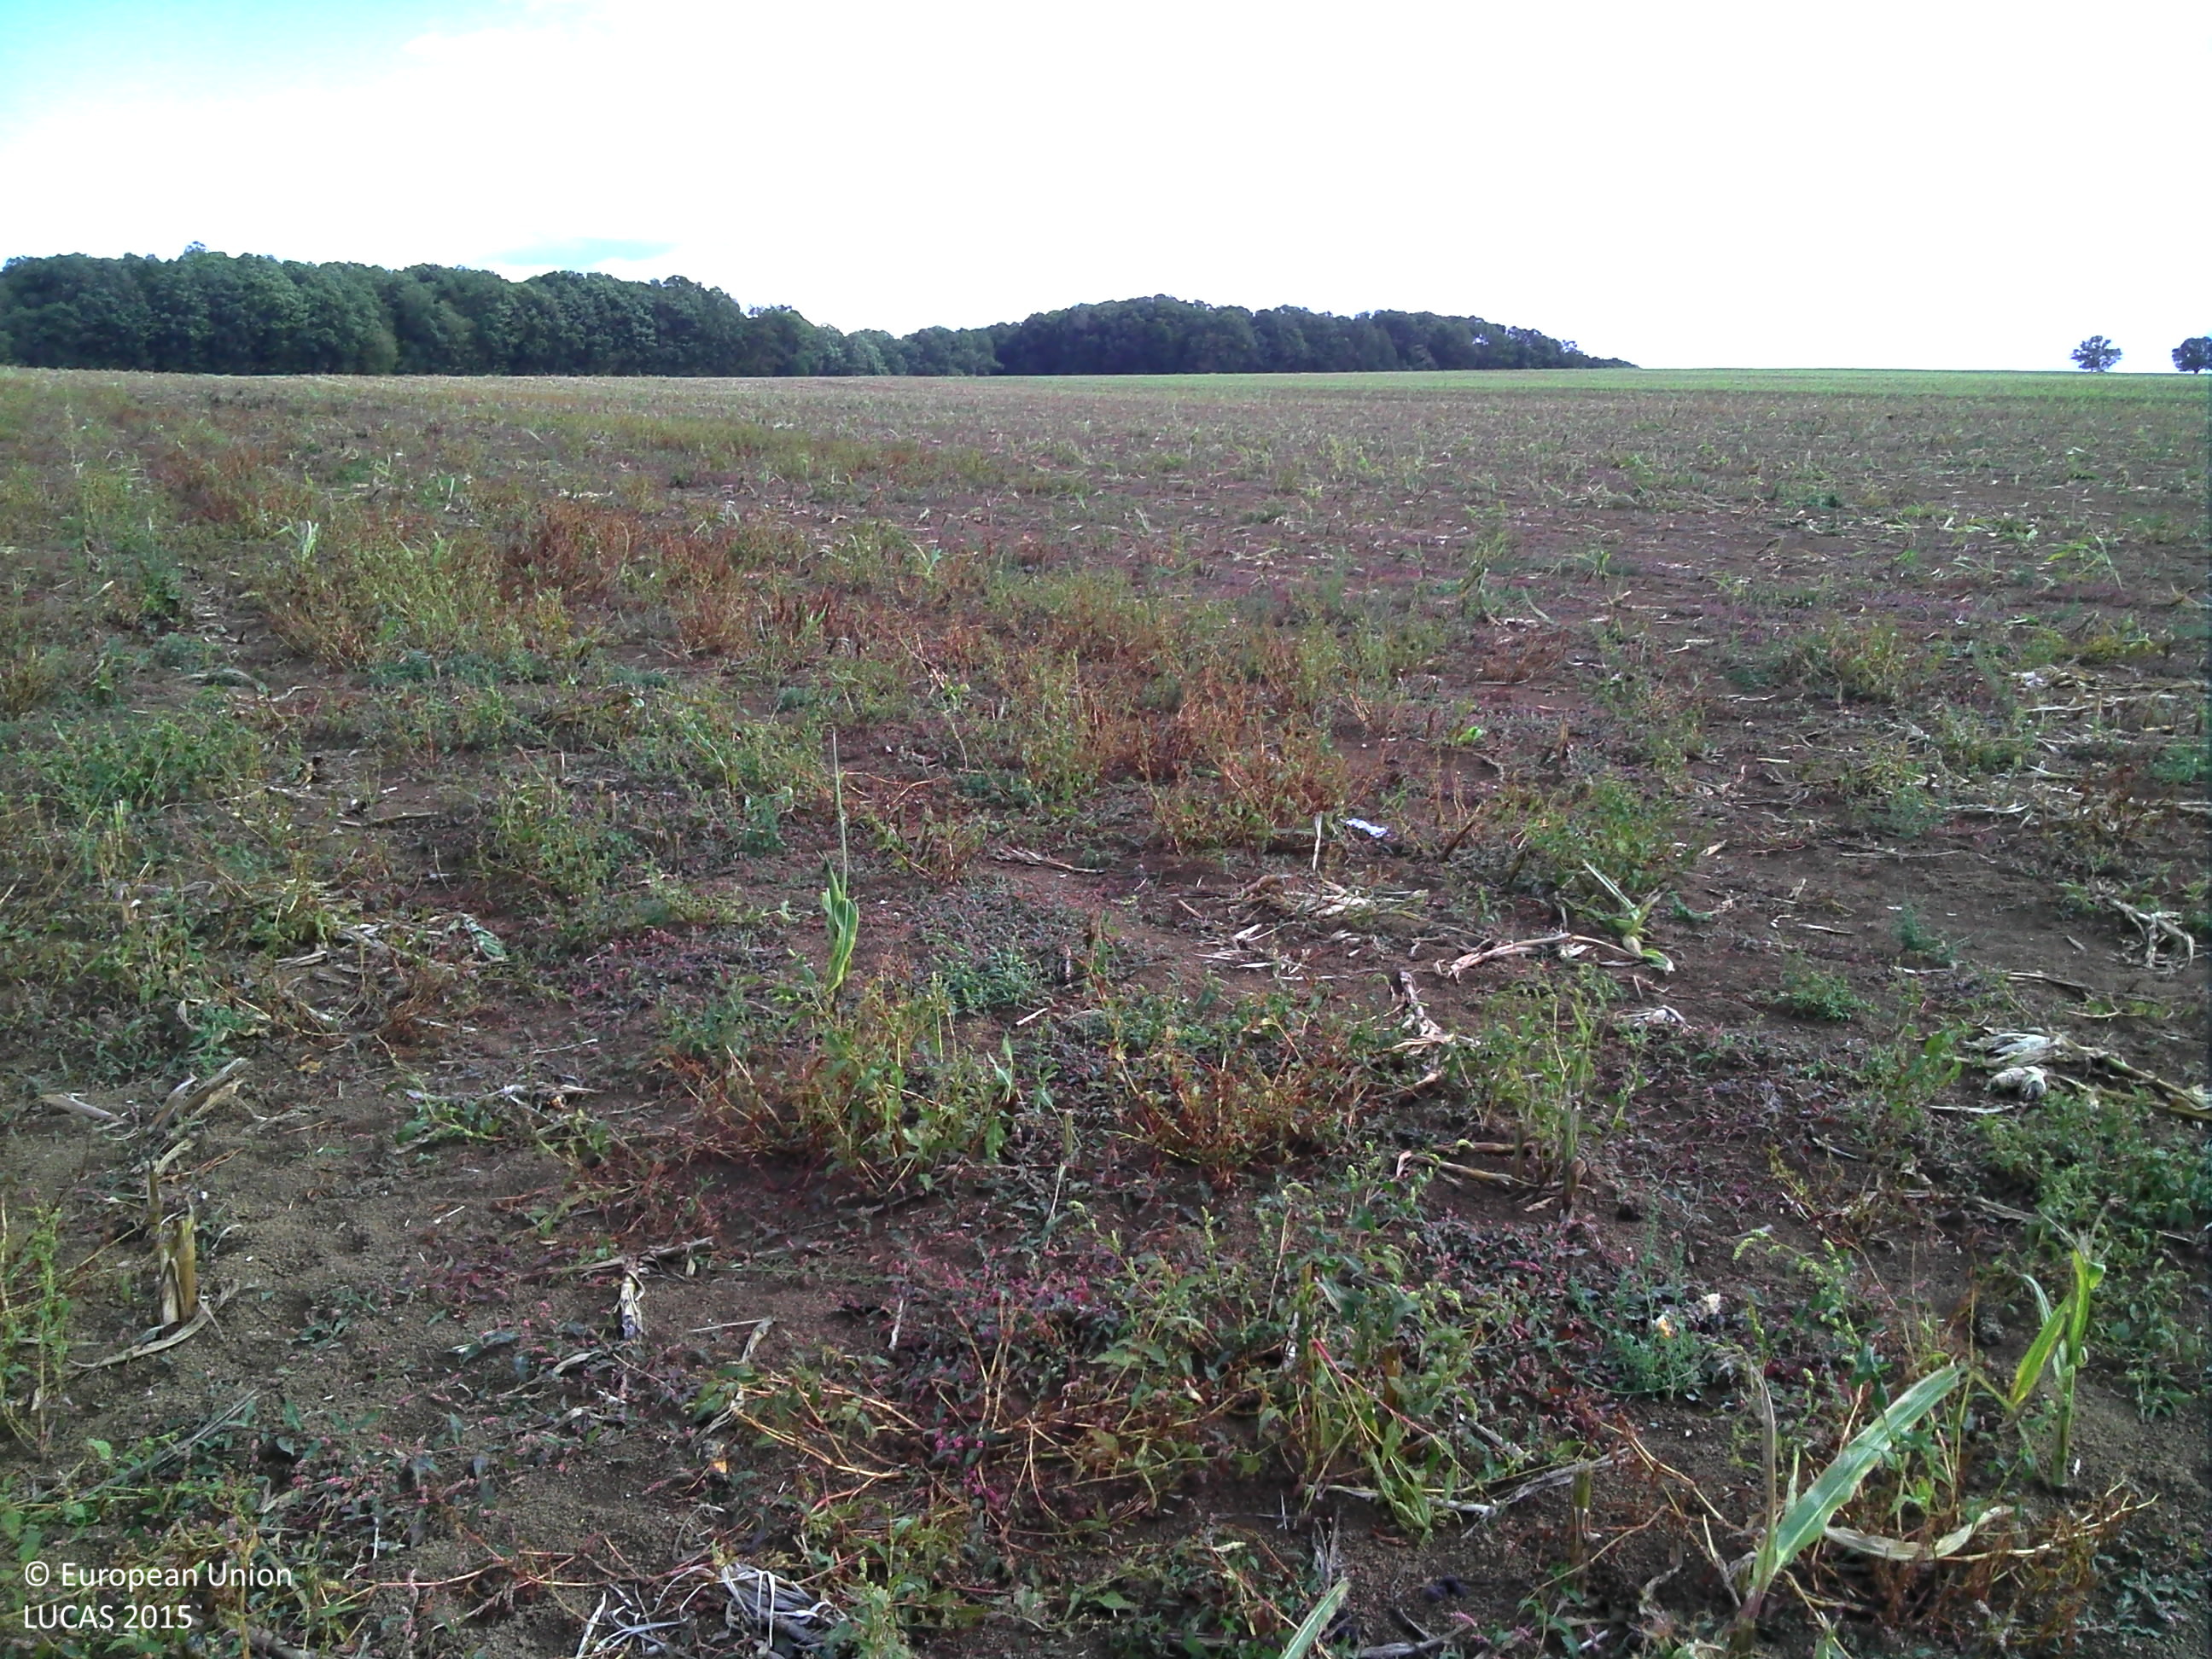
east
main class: Cropland
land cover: Maize
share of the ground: < 10 %
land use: Agriculture (excluding fallow land and kitchen gardens)
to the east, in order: Maize
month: September
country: FR
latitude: 48.3483
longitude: 4.6950
